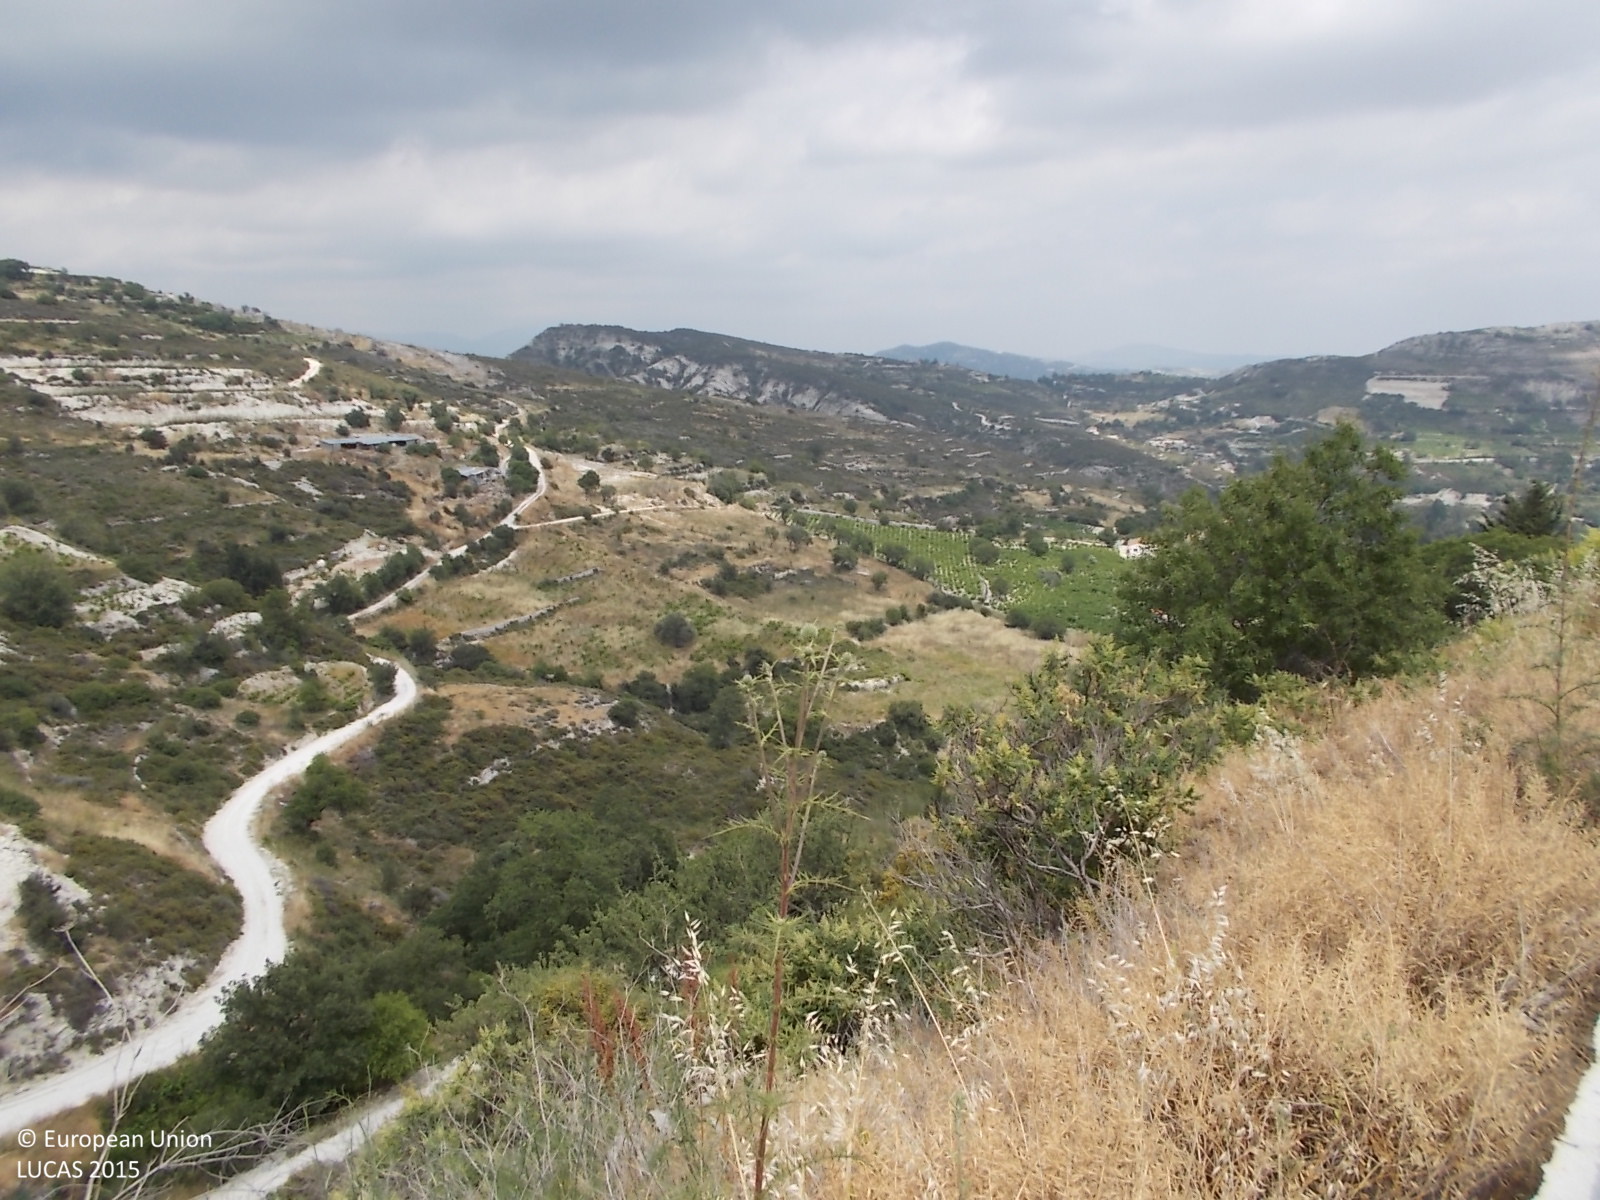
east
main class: Shrubland
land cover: Shrubland with sparse tree cover
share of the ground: 50 - 75 %
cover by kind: shrubs 60 %, herbaceous plants 15 %, unconsolidated bare surface 15 %, broadleaved forest trees 5 %, consolidated bare surface 5 %
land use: Semi-natural and natural areas not in use
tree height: < 5 m
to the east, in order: Shrubland with sparse tree cover; Paved roads, cycling and walking lanes; Shrubland with sparse tree cover; Other mixed woodland; Rocks and stones; Shrubland with sparse tree cover; Spontaneously vegetated surfaces
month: June
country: CY
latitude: 34.8492
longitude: 32.8570
